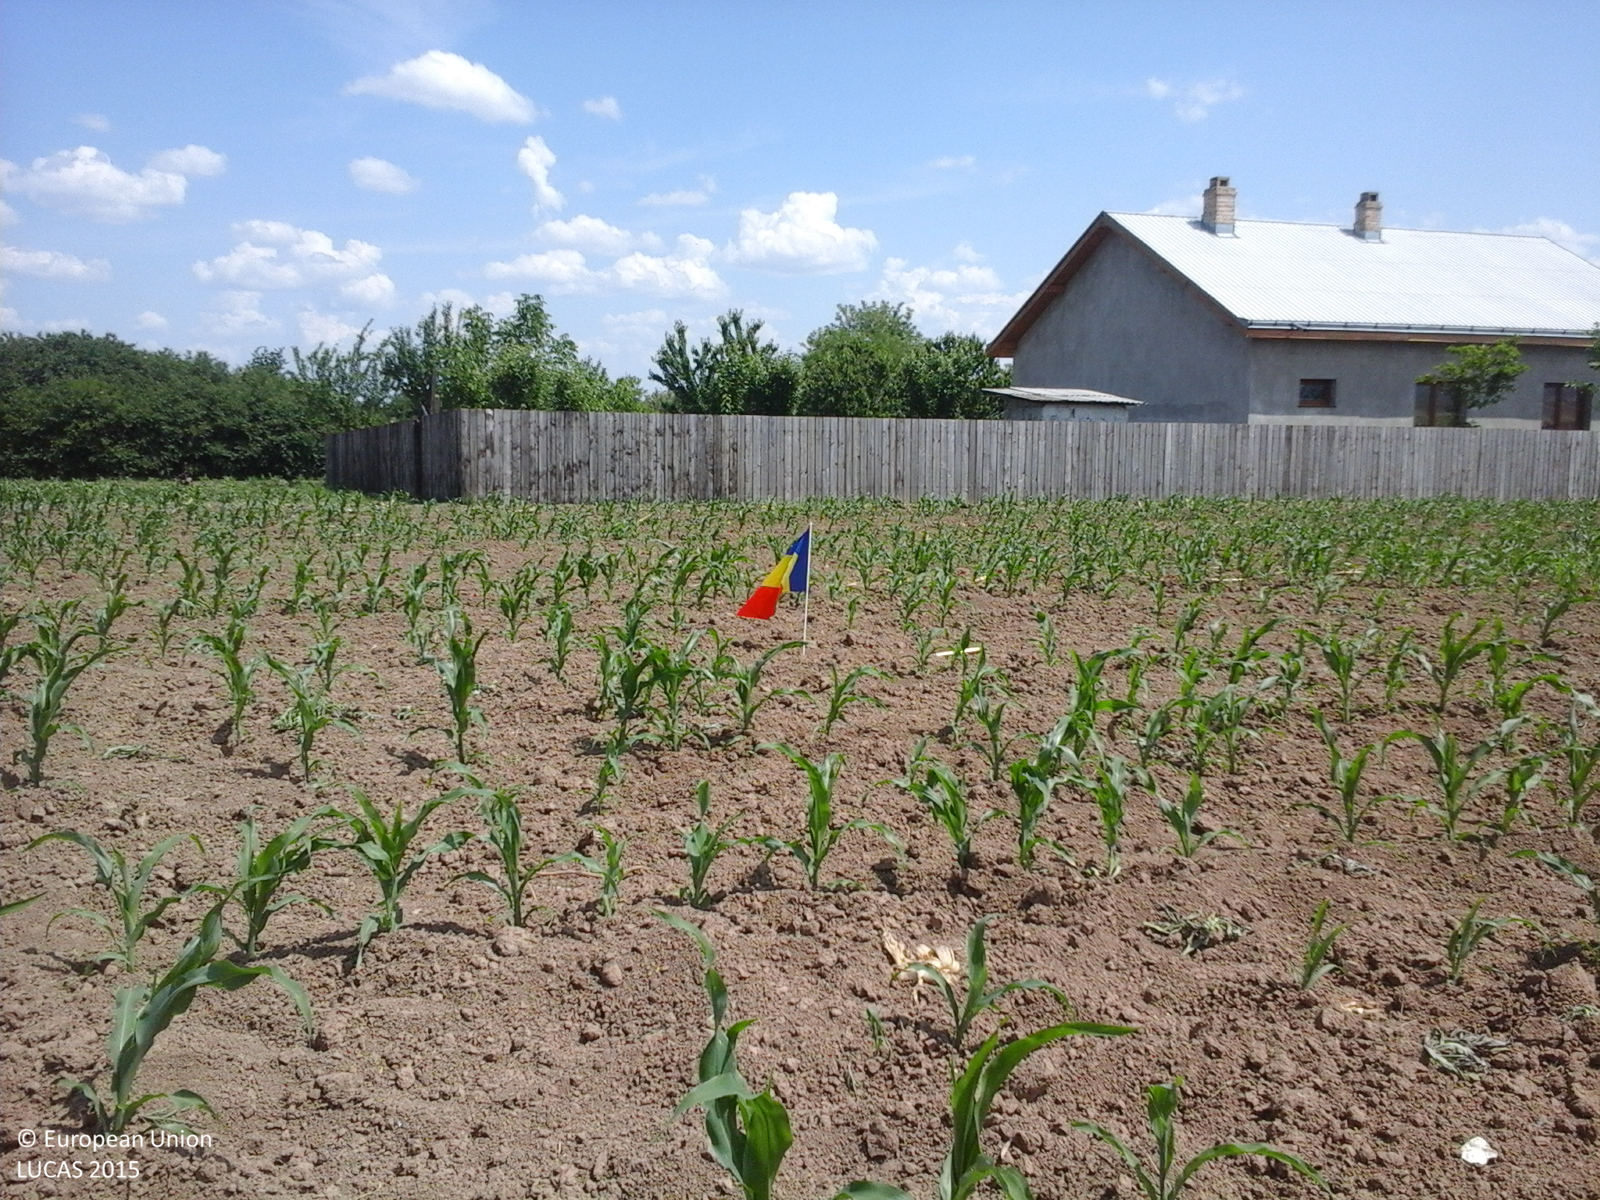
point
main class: Cropland
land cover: Maize
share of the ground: 10 - 25 %
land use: Agriculture (excluding fallow land and kitchen gardens)
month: June
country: RO
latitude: 46.7938
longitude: 26.7960
